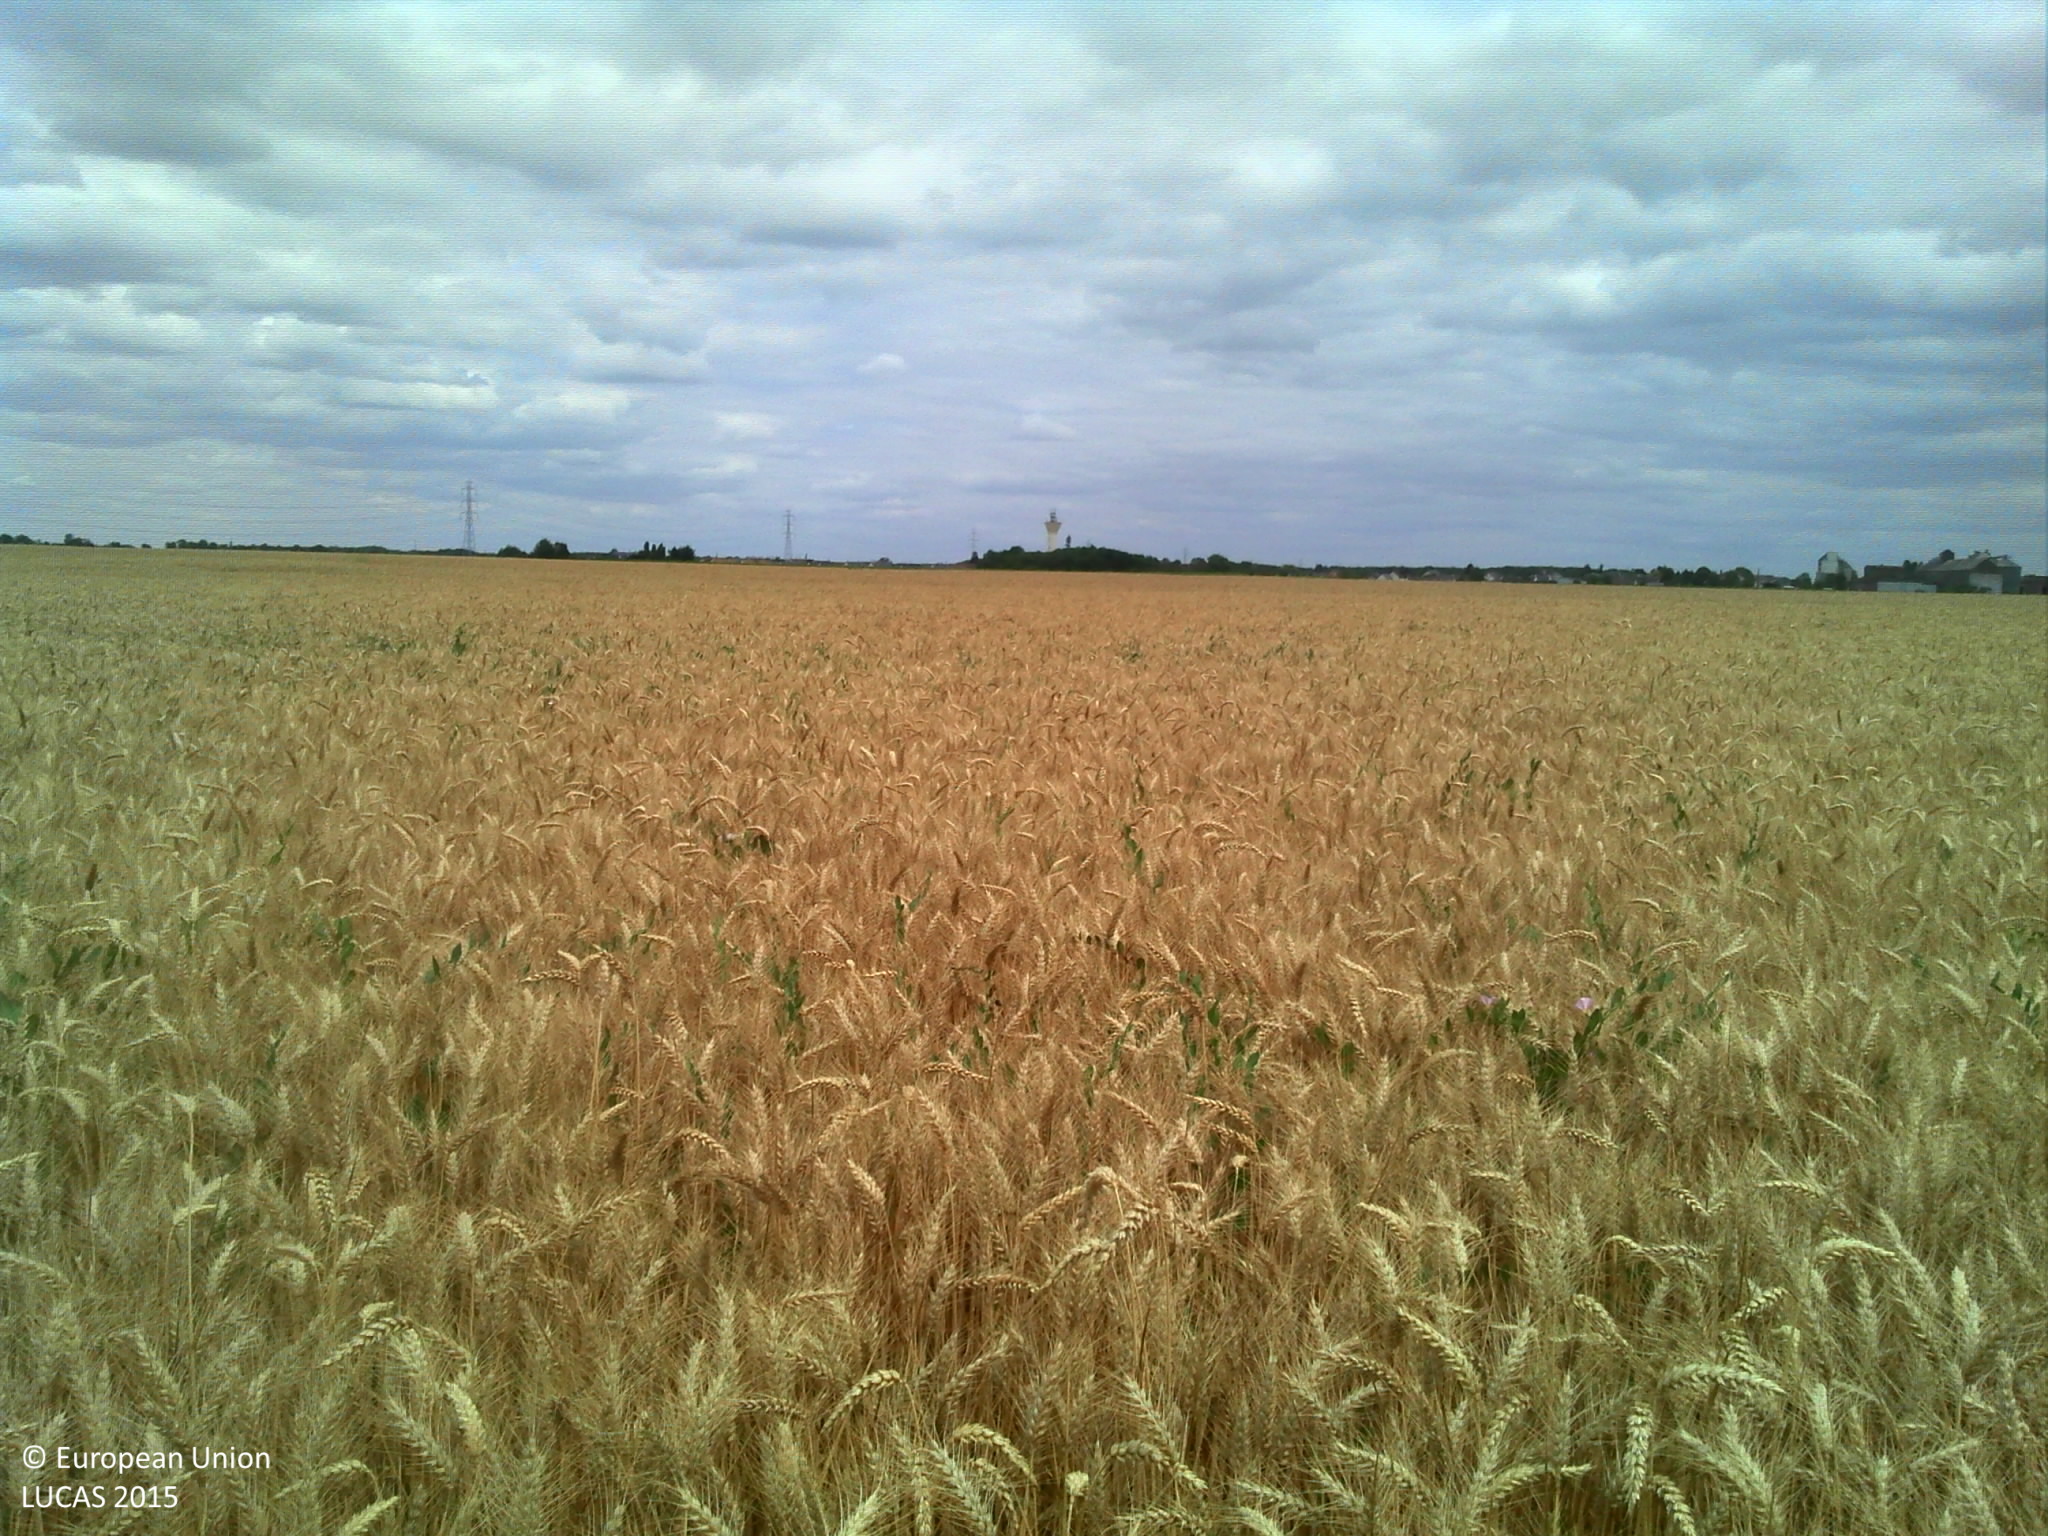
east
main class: Cropland
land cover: Common wheat
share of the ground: > 75 %
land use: Agriculture (excluding fallow land and kitchen gardens)
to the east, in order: Common wheat
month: July
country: FR
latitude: 47.3070
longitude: 0.5222
